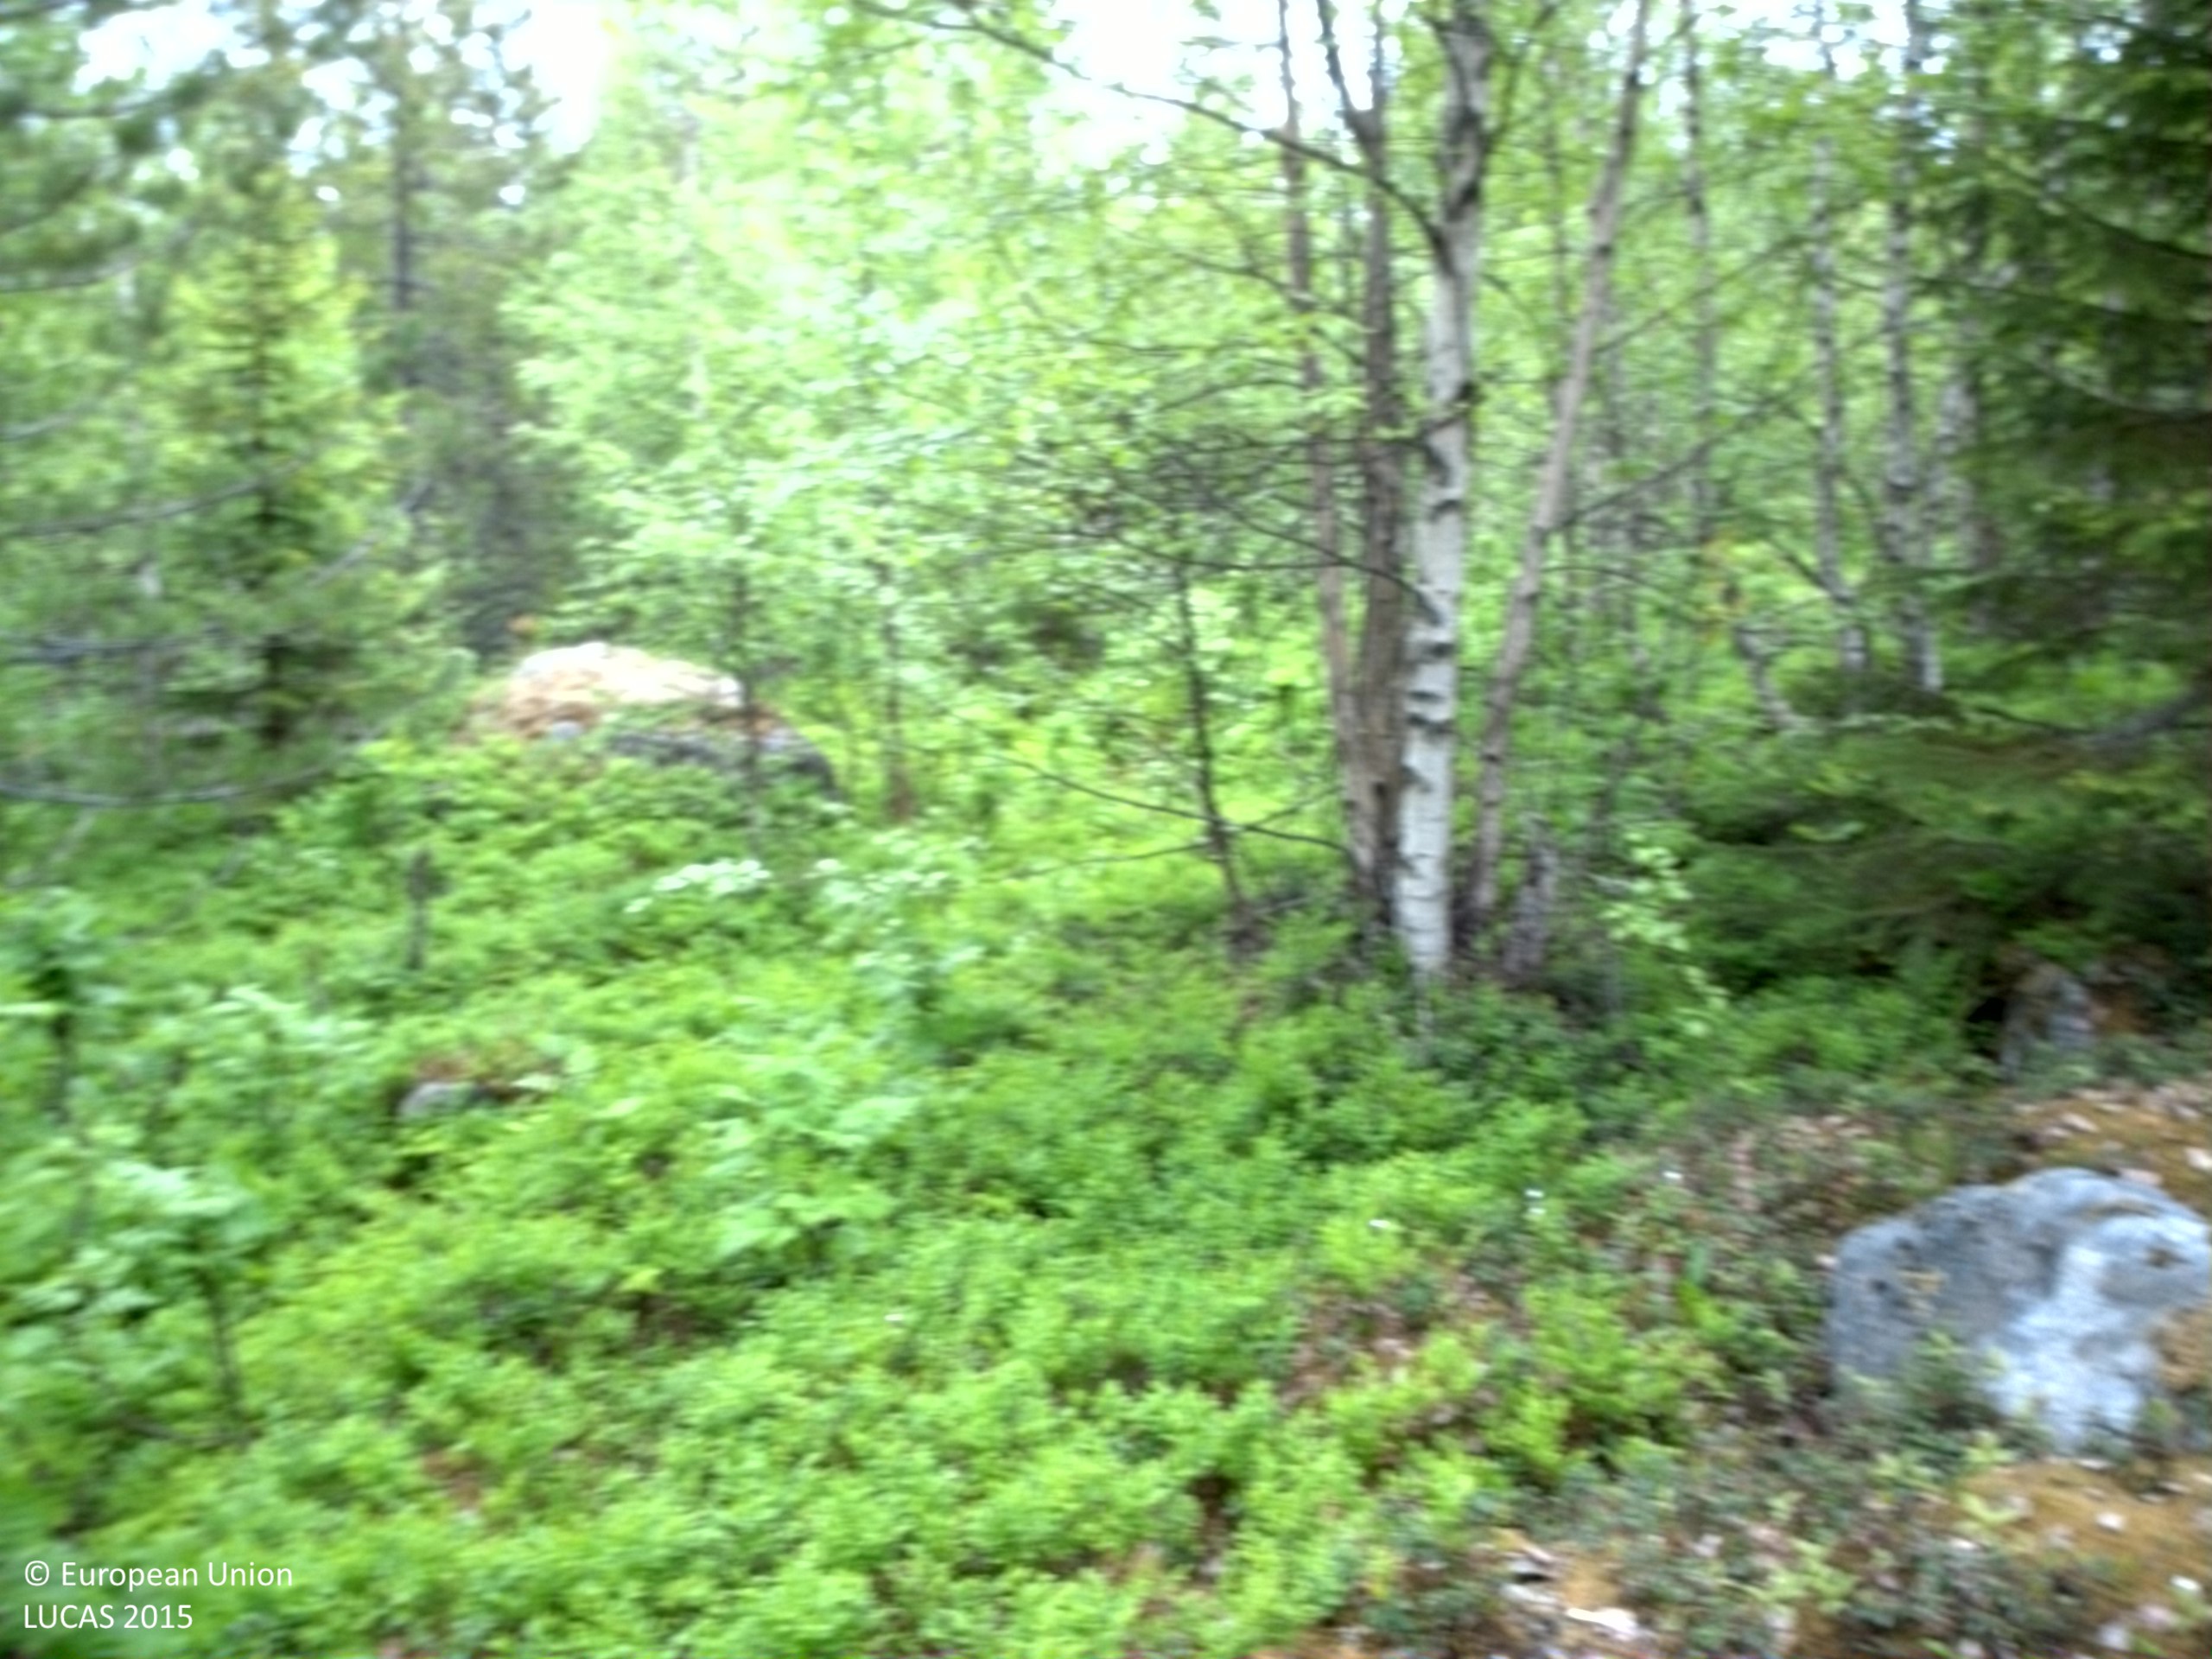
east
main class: Woodland
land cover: Other mixed woodland
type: boreal forest
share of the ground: 25 - 50 %
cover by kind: coniferous forest trees 30 %, shrubs 30 %, consolidated bare surface 30 %, broadleaved forest trees 10 %
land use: Forestry
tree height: > 5 m
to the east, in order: Other mixed woodland; Pine dominated coniferous woodland; Broadleaved woodland; Ditches and canals; Broadleaved woodland
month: June
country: SE
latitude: 63.1666
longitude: 17.8997
